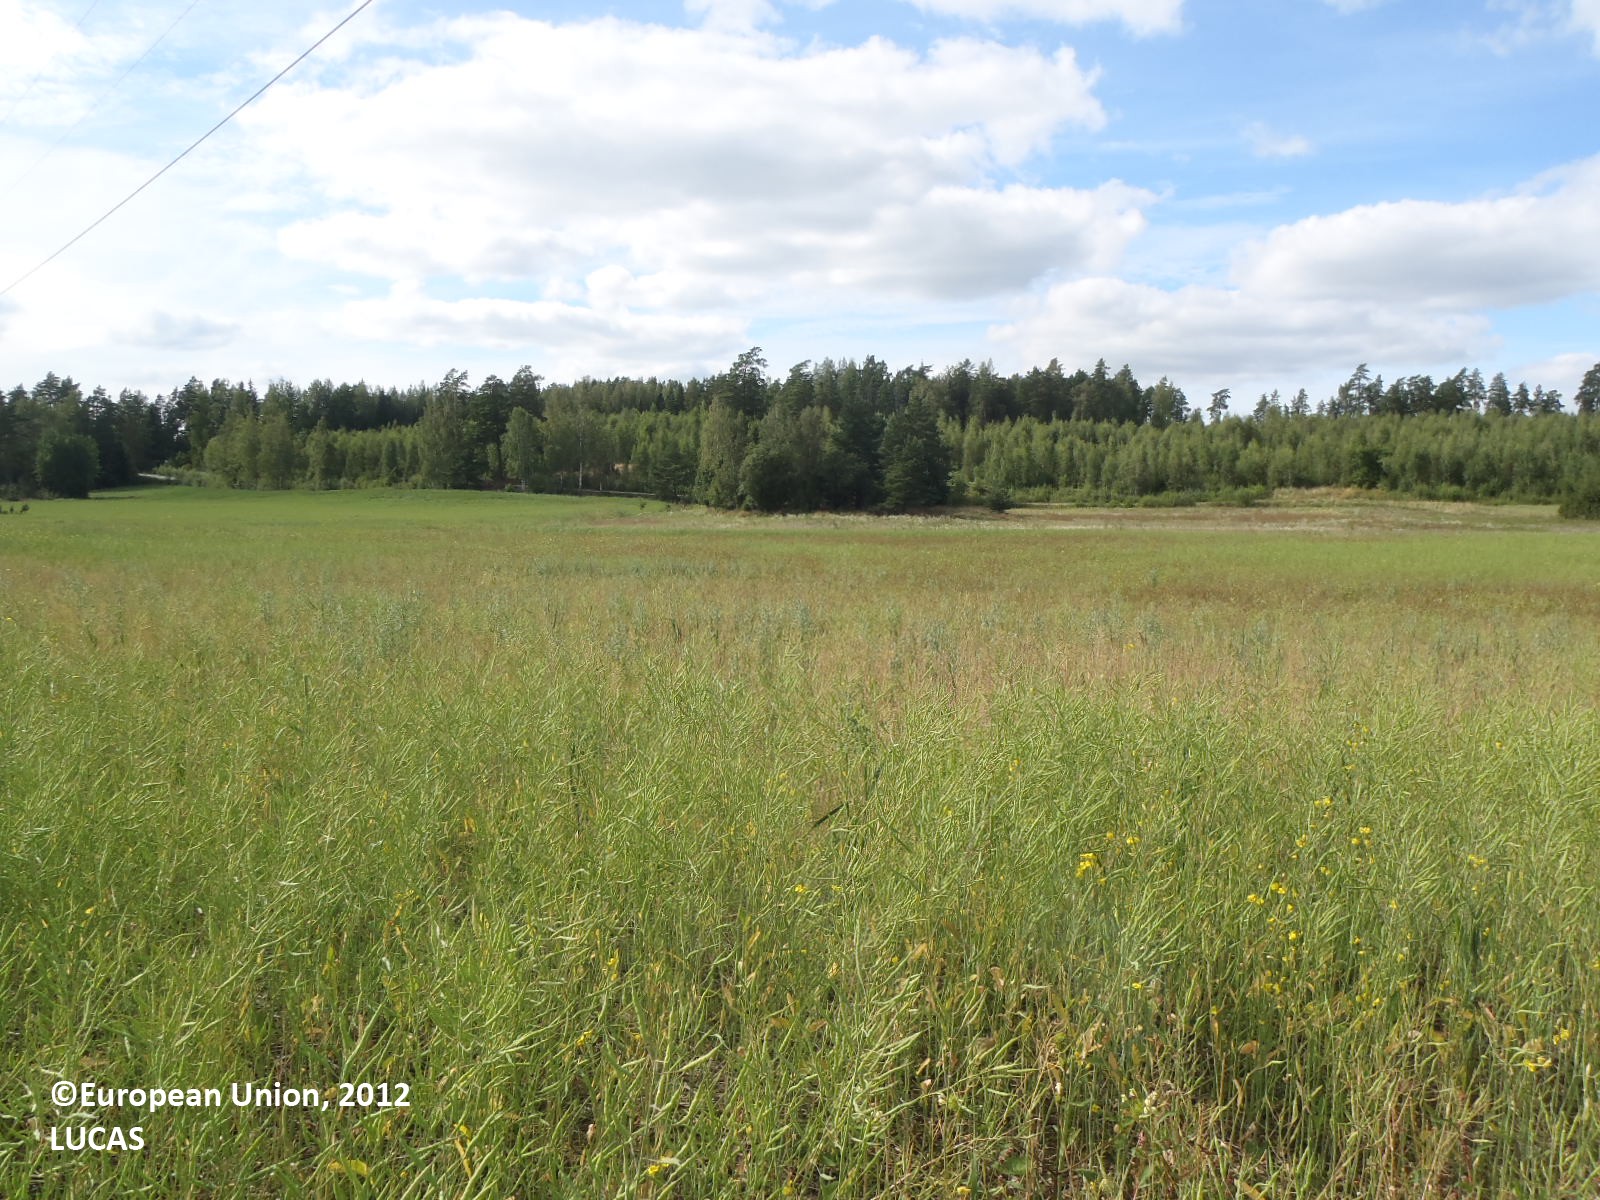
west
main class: Cropland
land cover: Rape and turnip rape
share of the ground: > 75 %
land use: Agriculture (excluding fallow land and kitchen gardens)
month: August
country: FI
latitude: 60.3360
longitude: 22.4791
